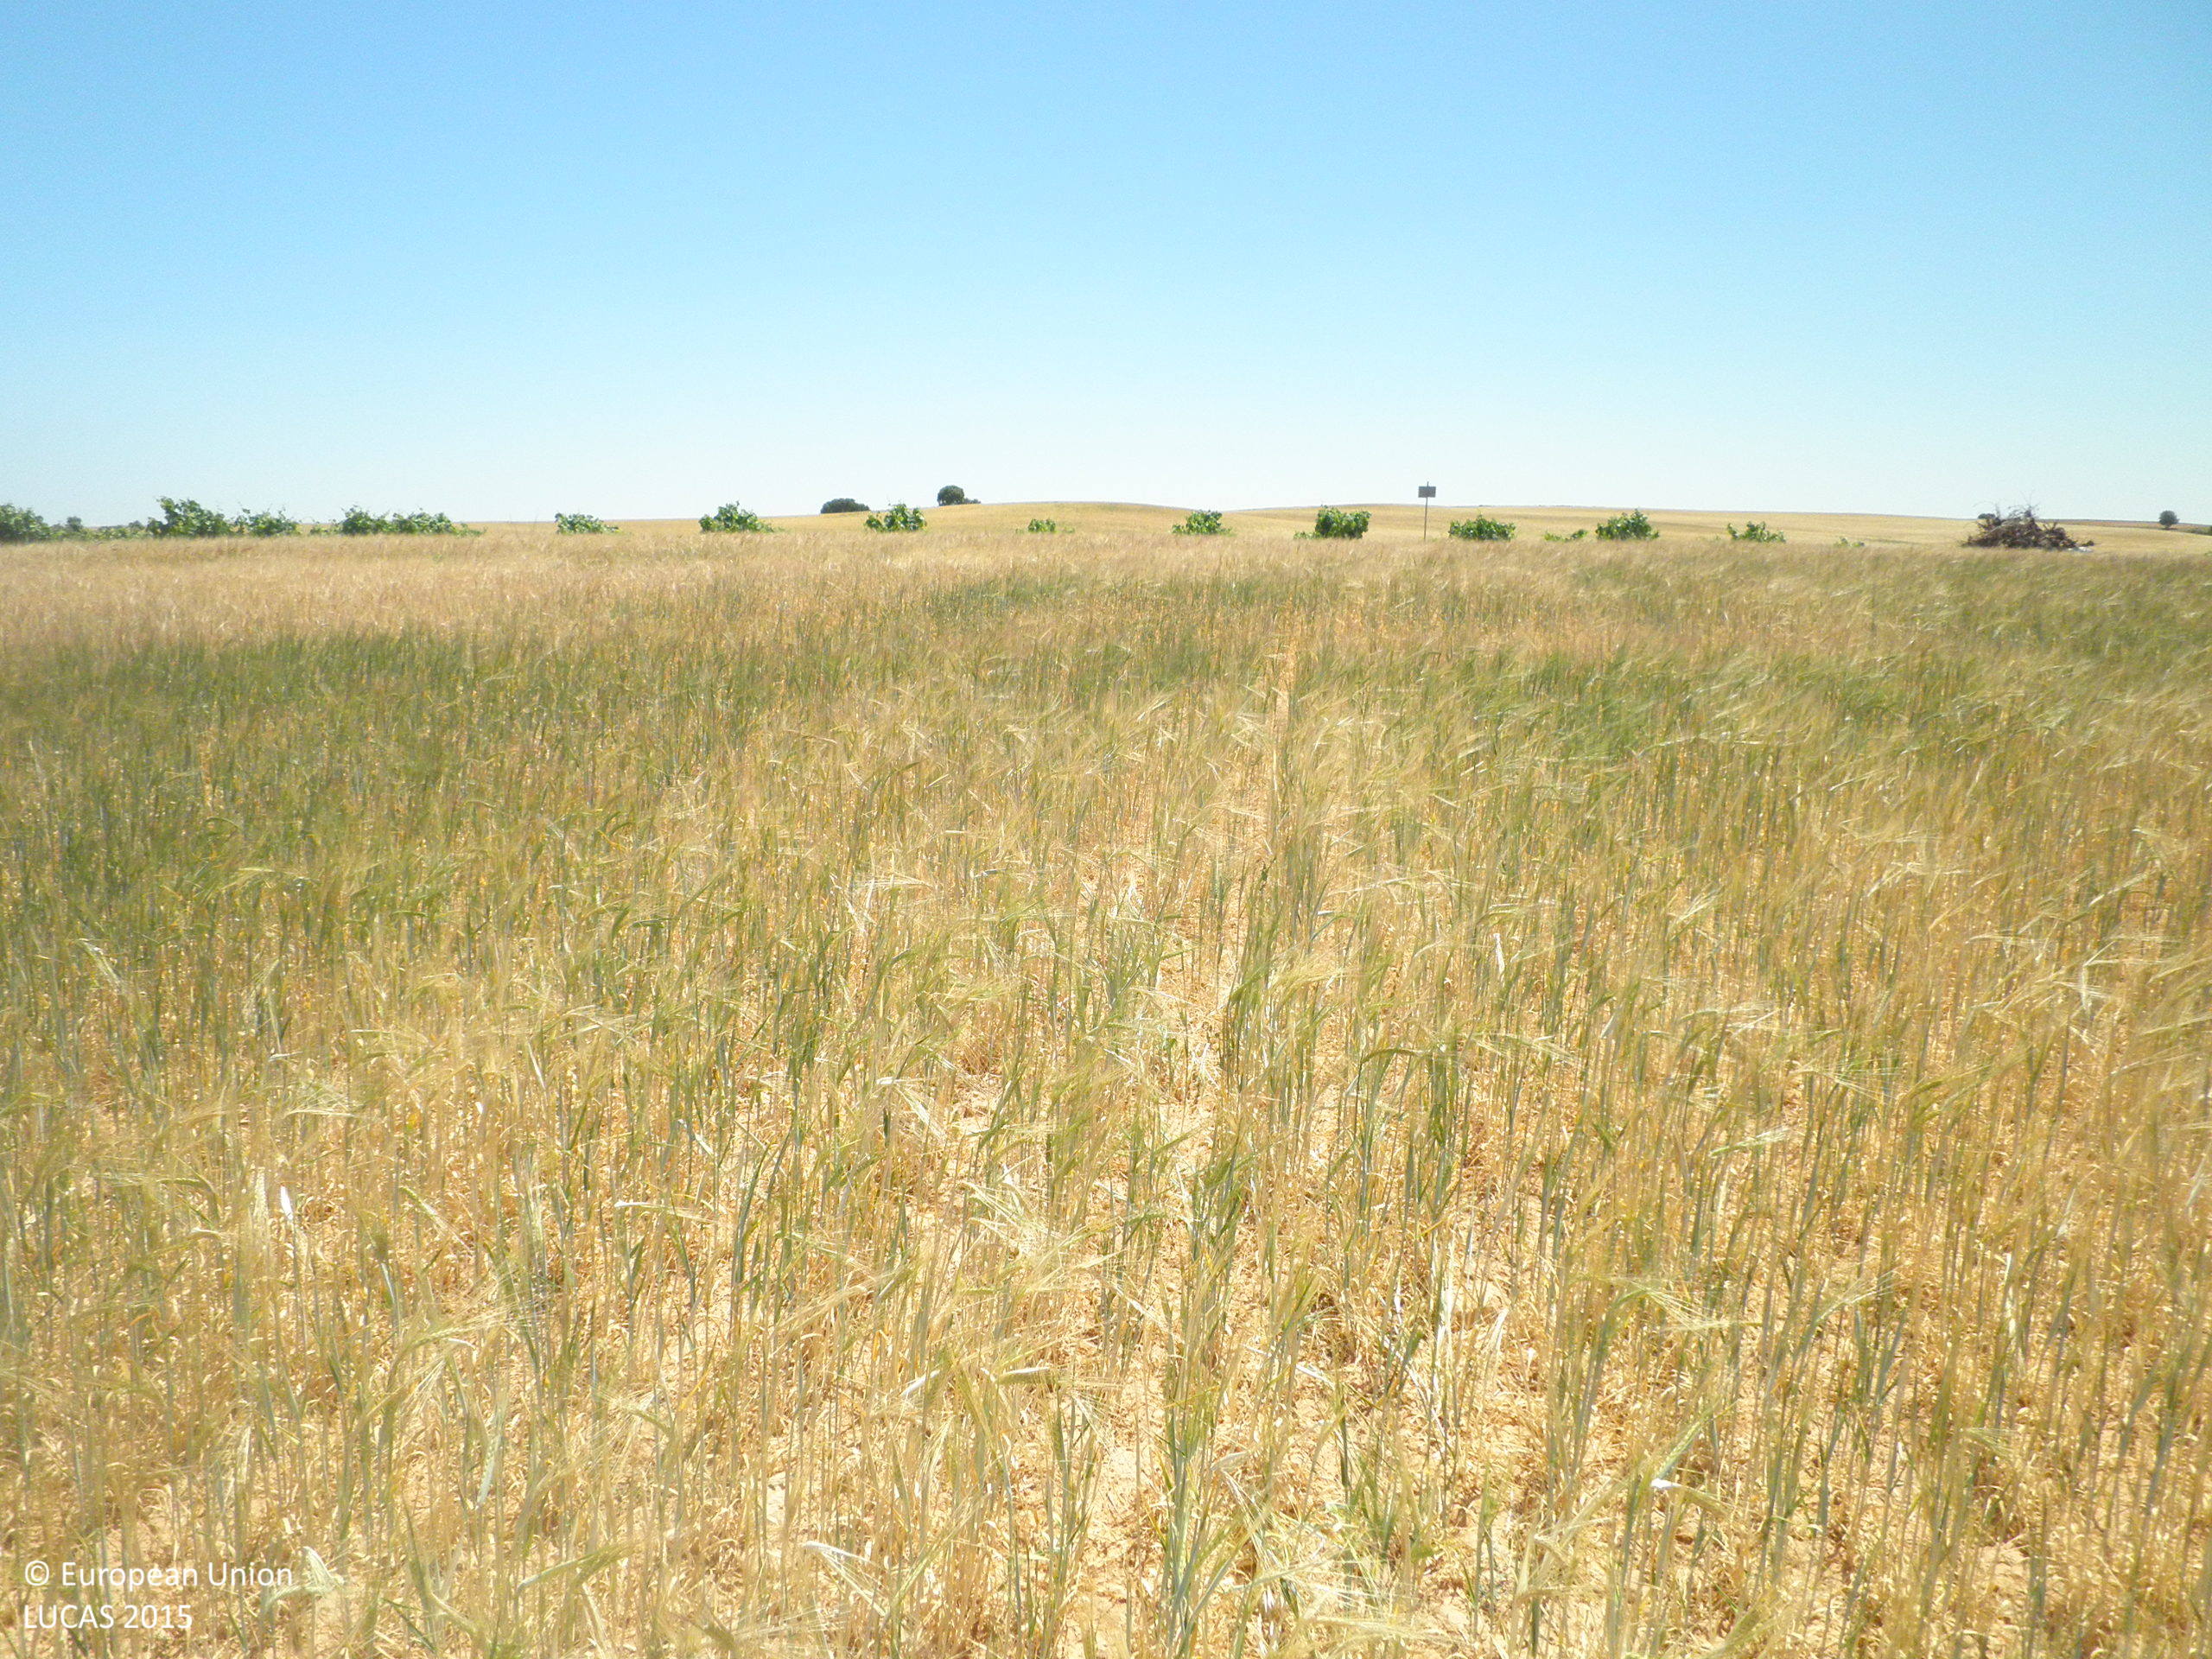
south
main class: Cropland
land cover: Barley
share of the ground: 50 - 75 %
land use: Agriculture (excluding fallow land and kitchen gardens)
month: June
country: ES
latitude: 39.4955
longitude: -1.6682
